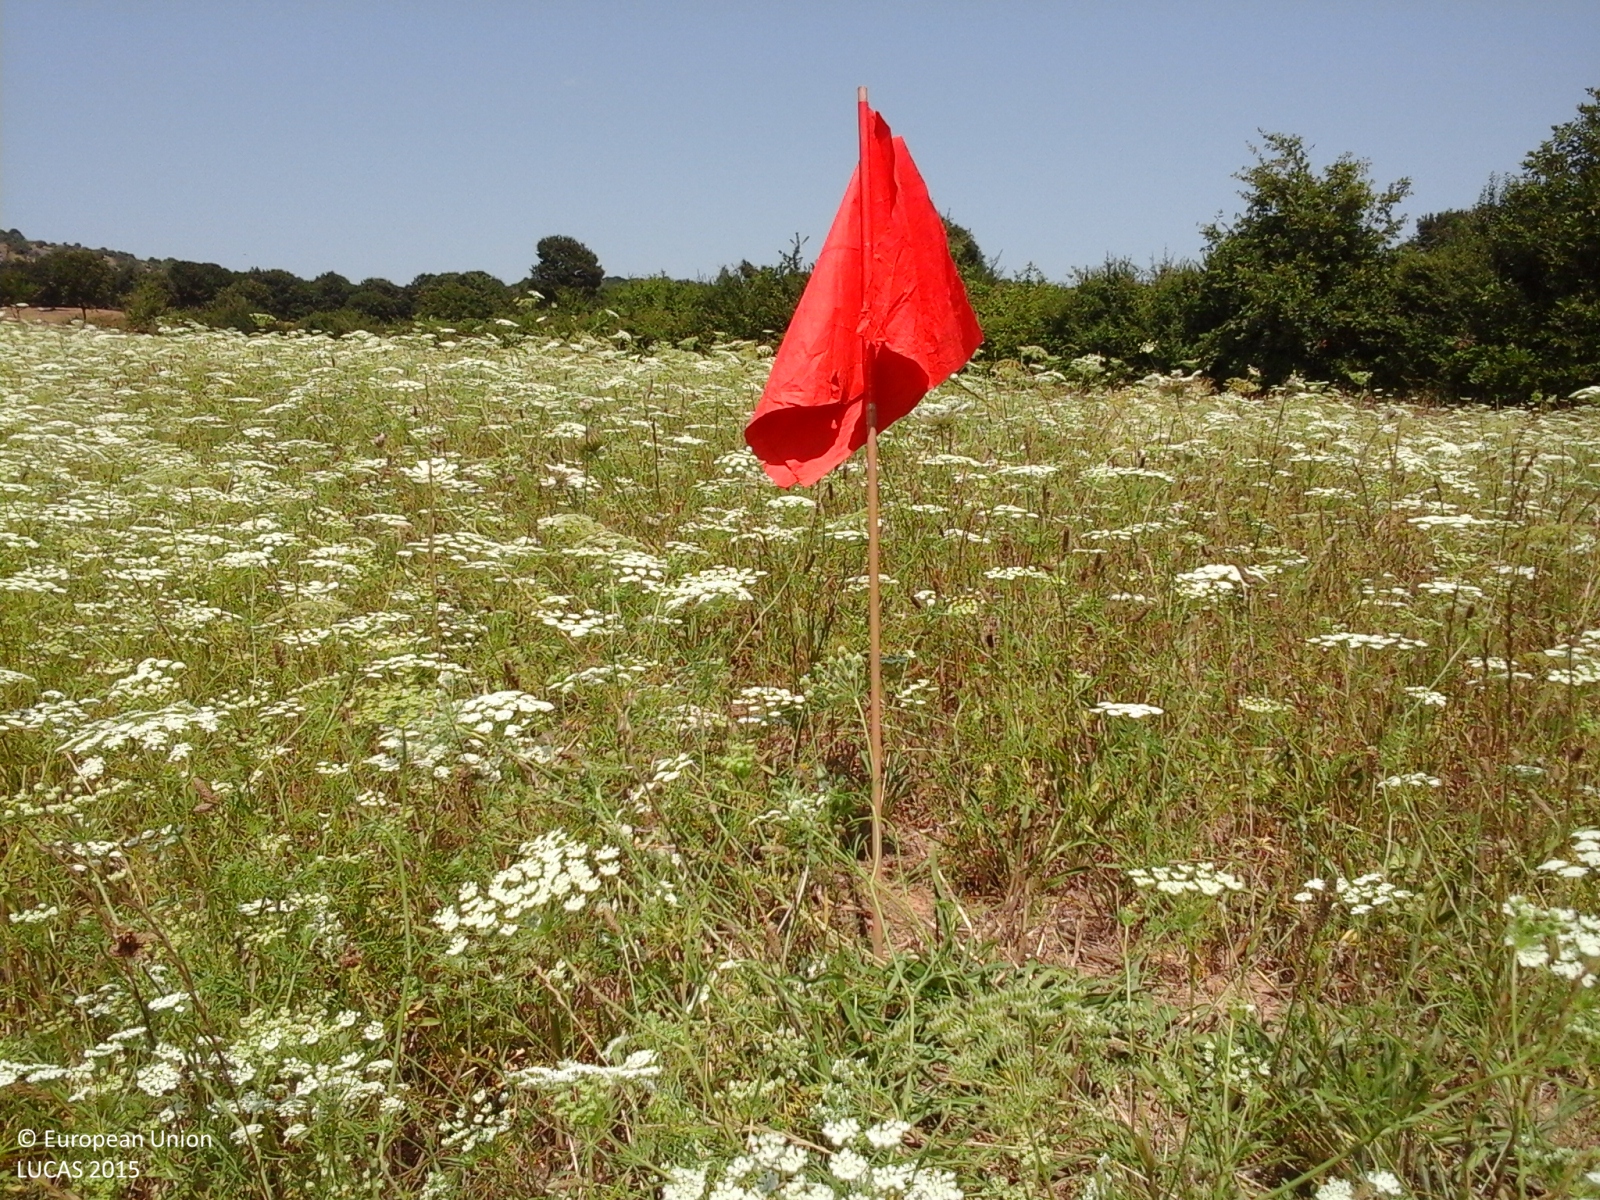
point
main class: Cropland
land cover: Temporary grasslands
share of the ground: > 75 %
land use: Agriculture (excluding fallow land and kitchen gardens)
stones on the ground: < 10 %
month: July
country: IT
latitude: 42.4805
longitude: 11.4911
